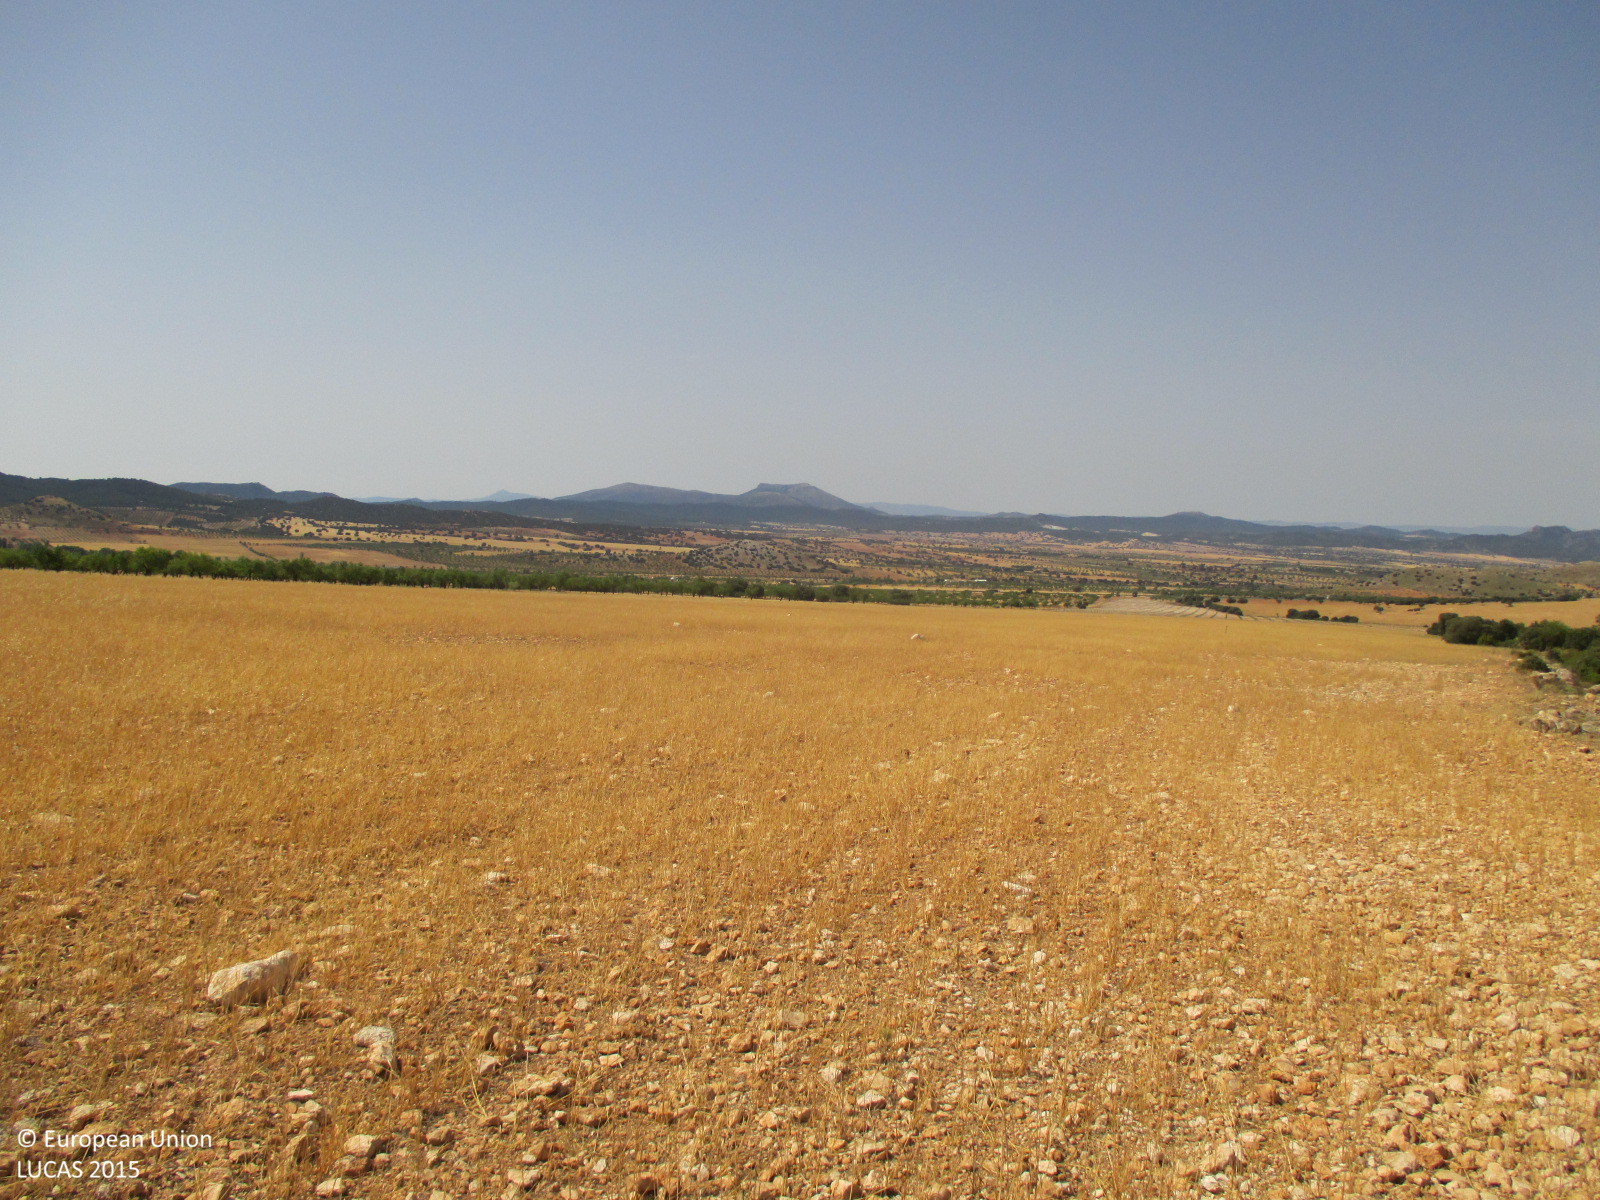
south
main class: Cropland
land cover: Oats
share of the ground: < 10 %
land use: Agriculture (excluding fallow land and kitchen gardens)
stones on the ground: < 10 %
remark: Harvested field
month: June
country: ES
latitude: 37.6059
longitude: -2.4352
